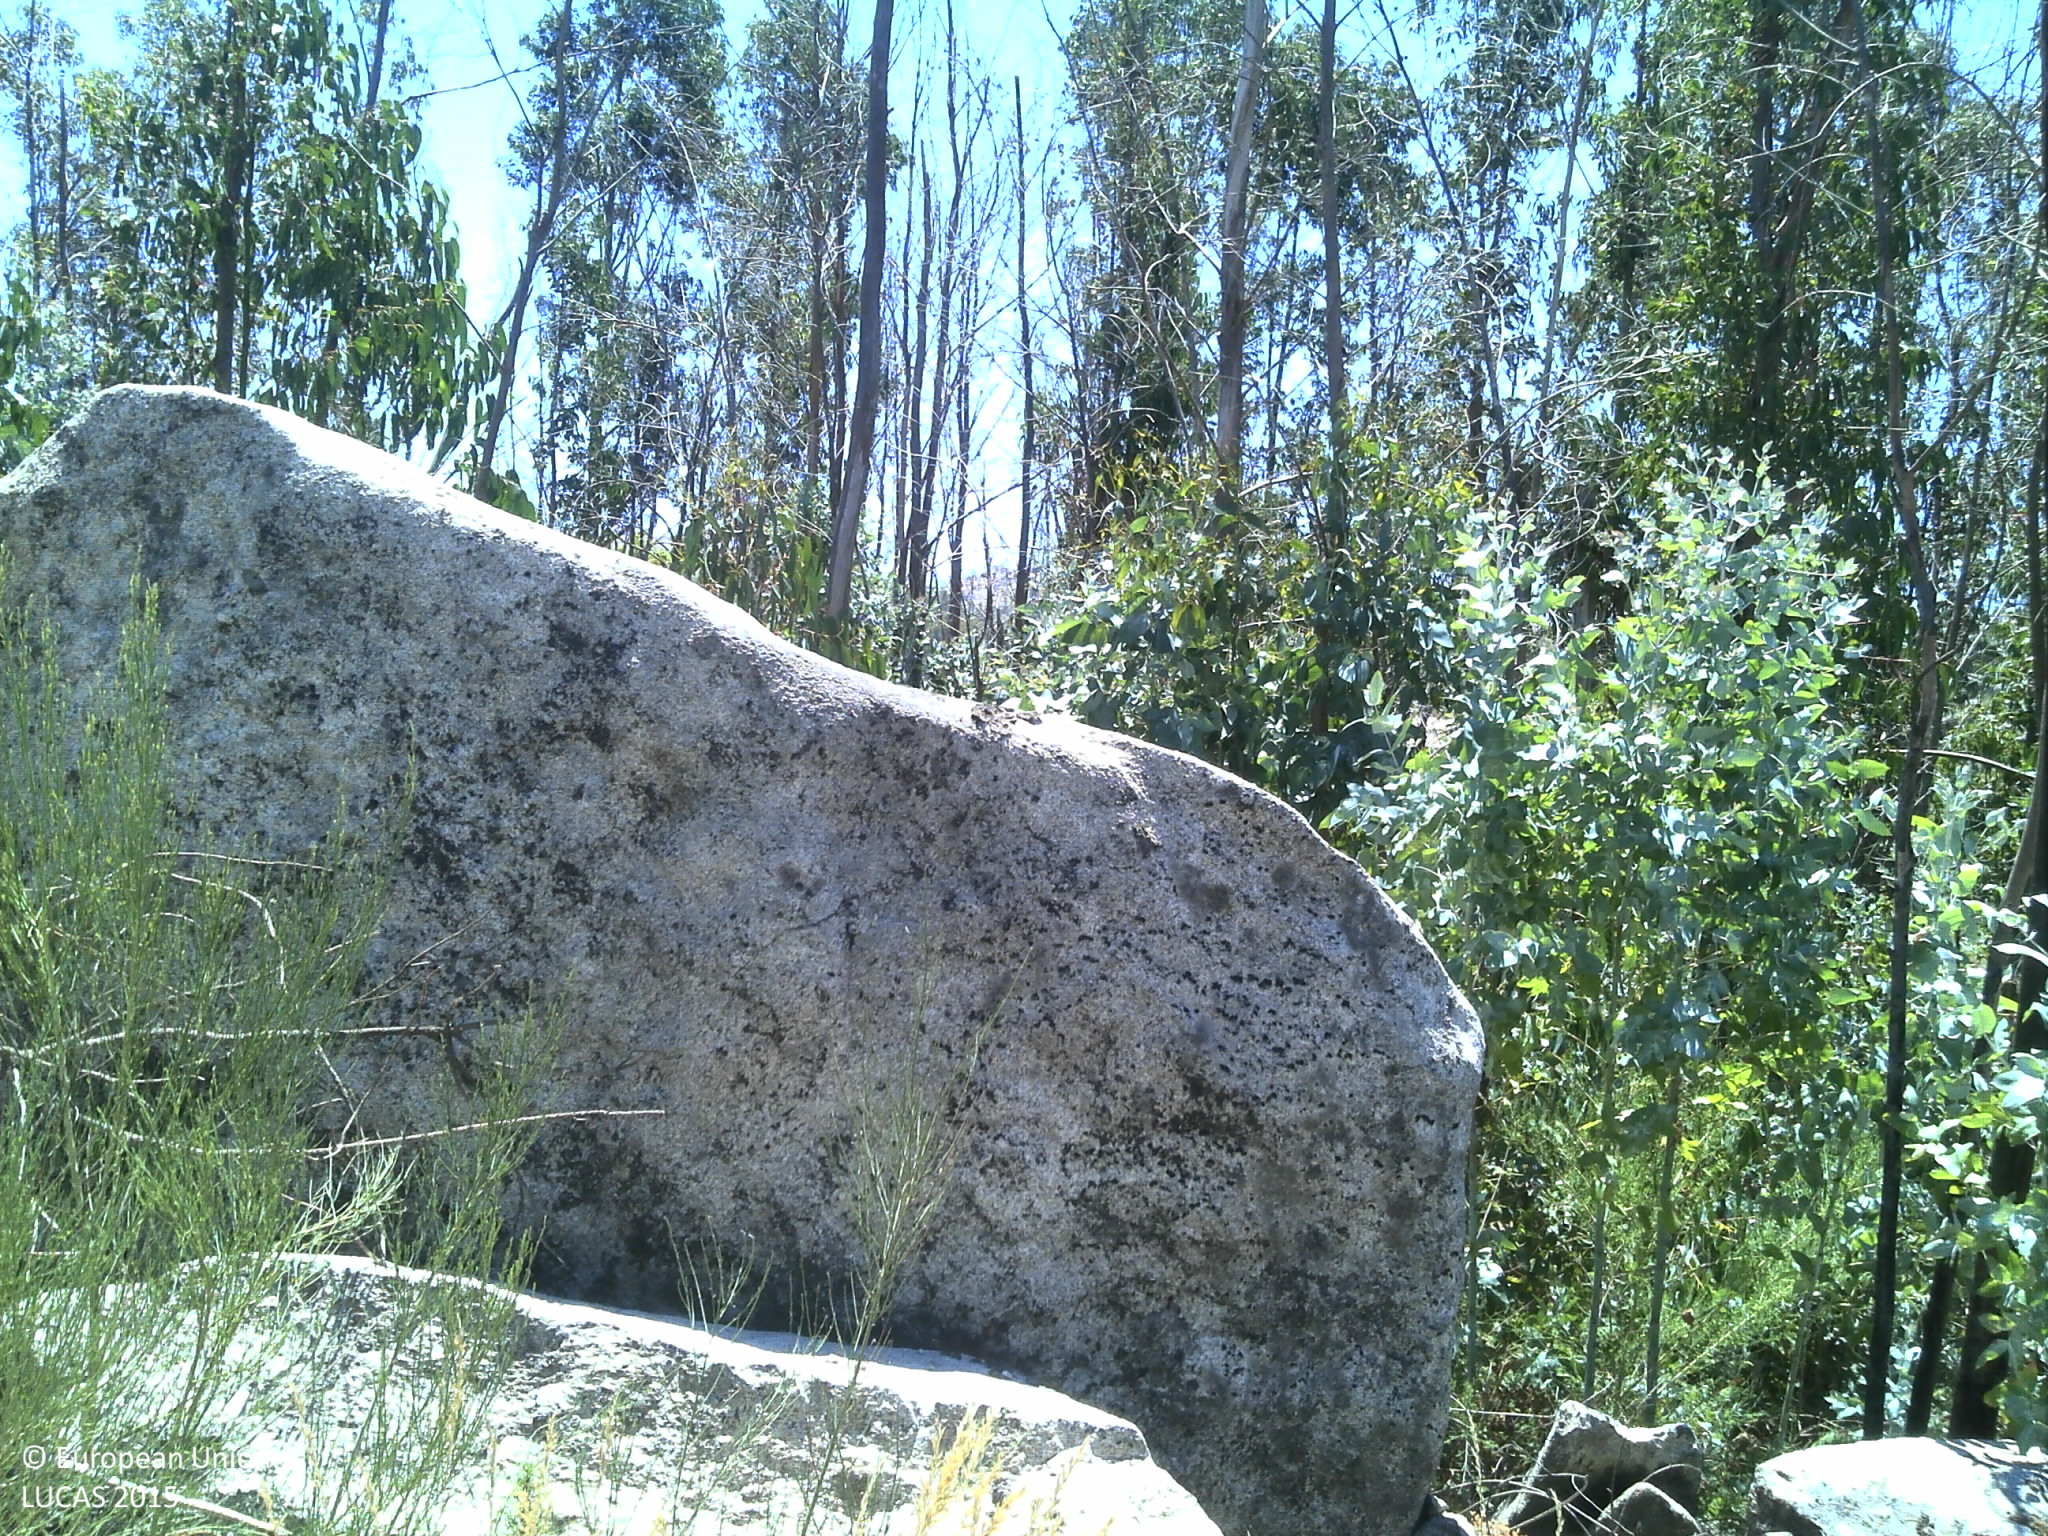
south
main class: Woodland
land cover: Broadleaved woodland
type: exotic forest
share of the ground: 50 - 75 %
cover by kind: broadleaved forest trees 50 %, consolidated bare surface 25 %, shrubs 10 %, herbaceous plants 10 %, unconsolidated bare surface 5 %
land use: Forestry
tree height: < 5 m
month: June
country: PT
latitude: 40.5569
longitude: -8.2358
